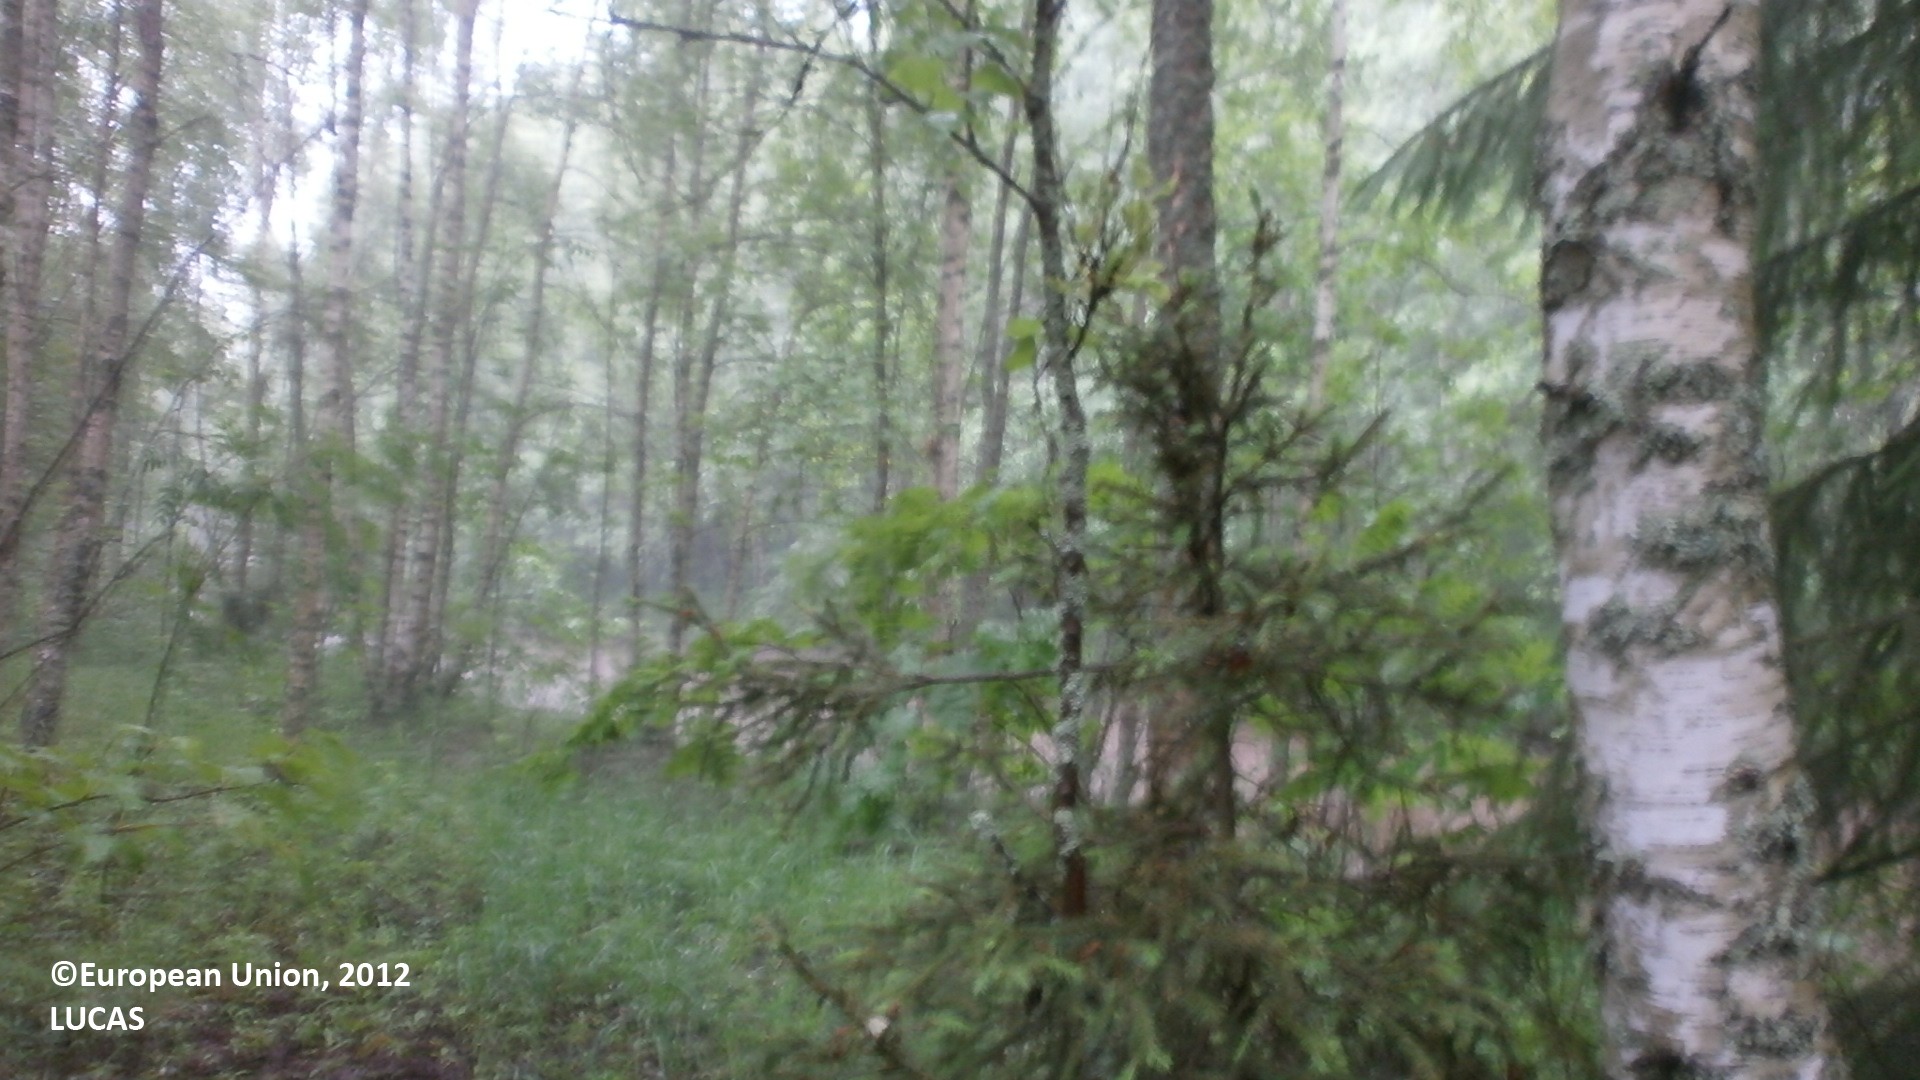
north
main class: Woodland
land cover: Broadleaved woodland
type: boreal forest
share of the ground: 50 - 75 %
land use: Forestry
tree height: > 5 m
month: June
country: FI
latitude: 64.8387
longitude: 25.2363
